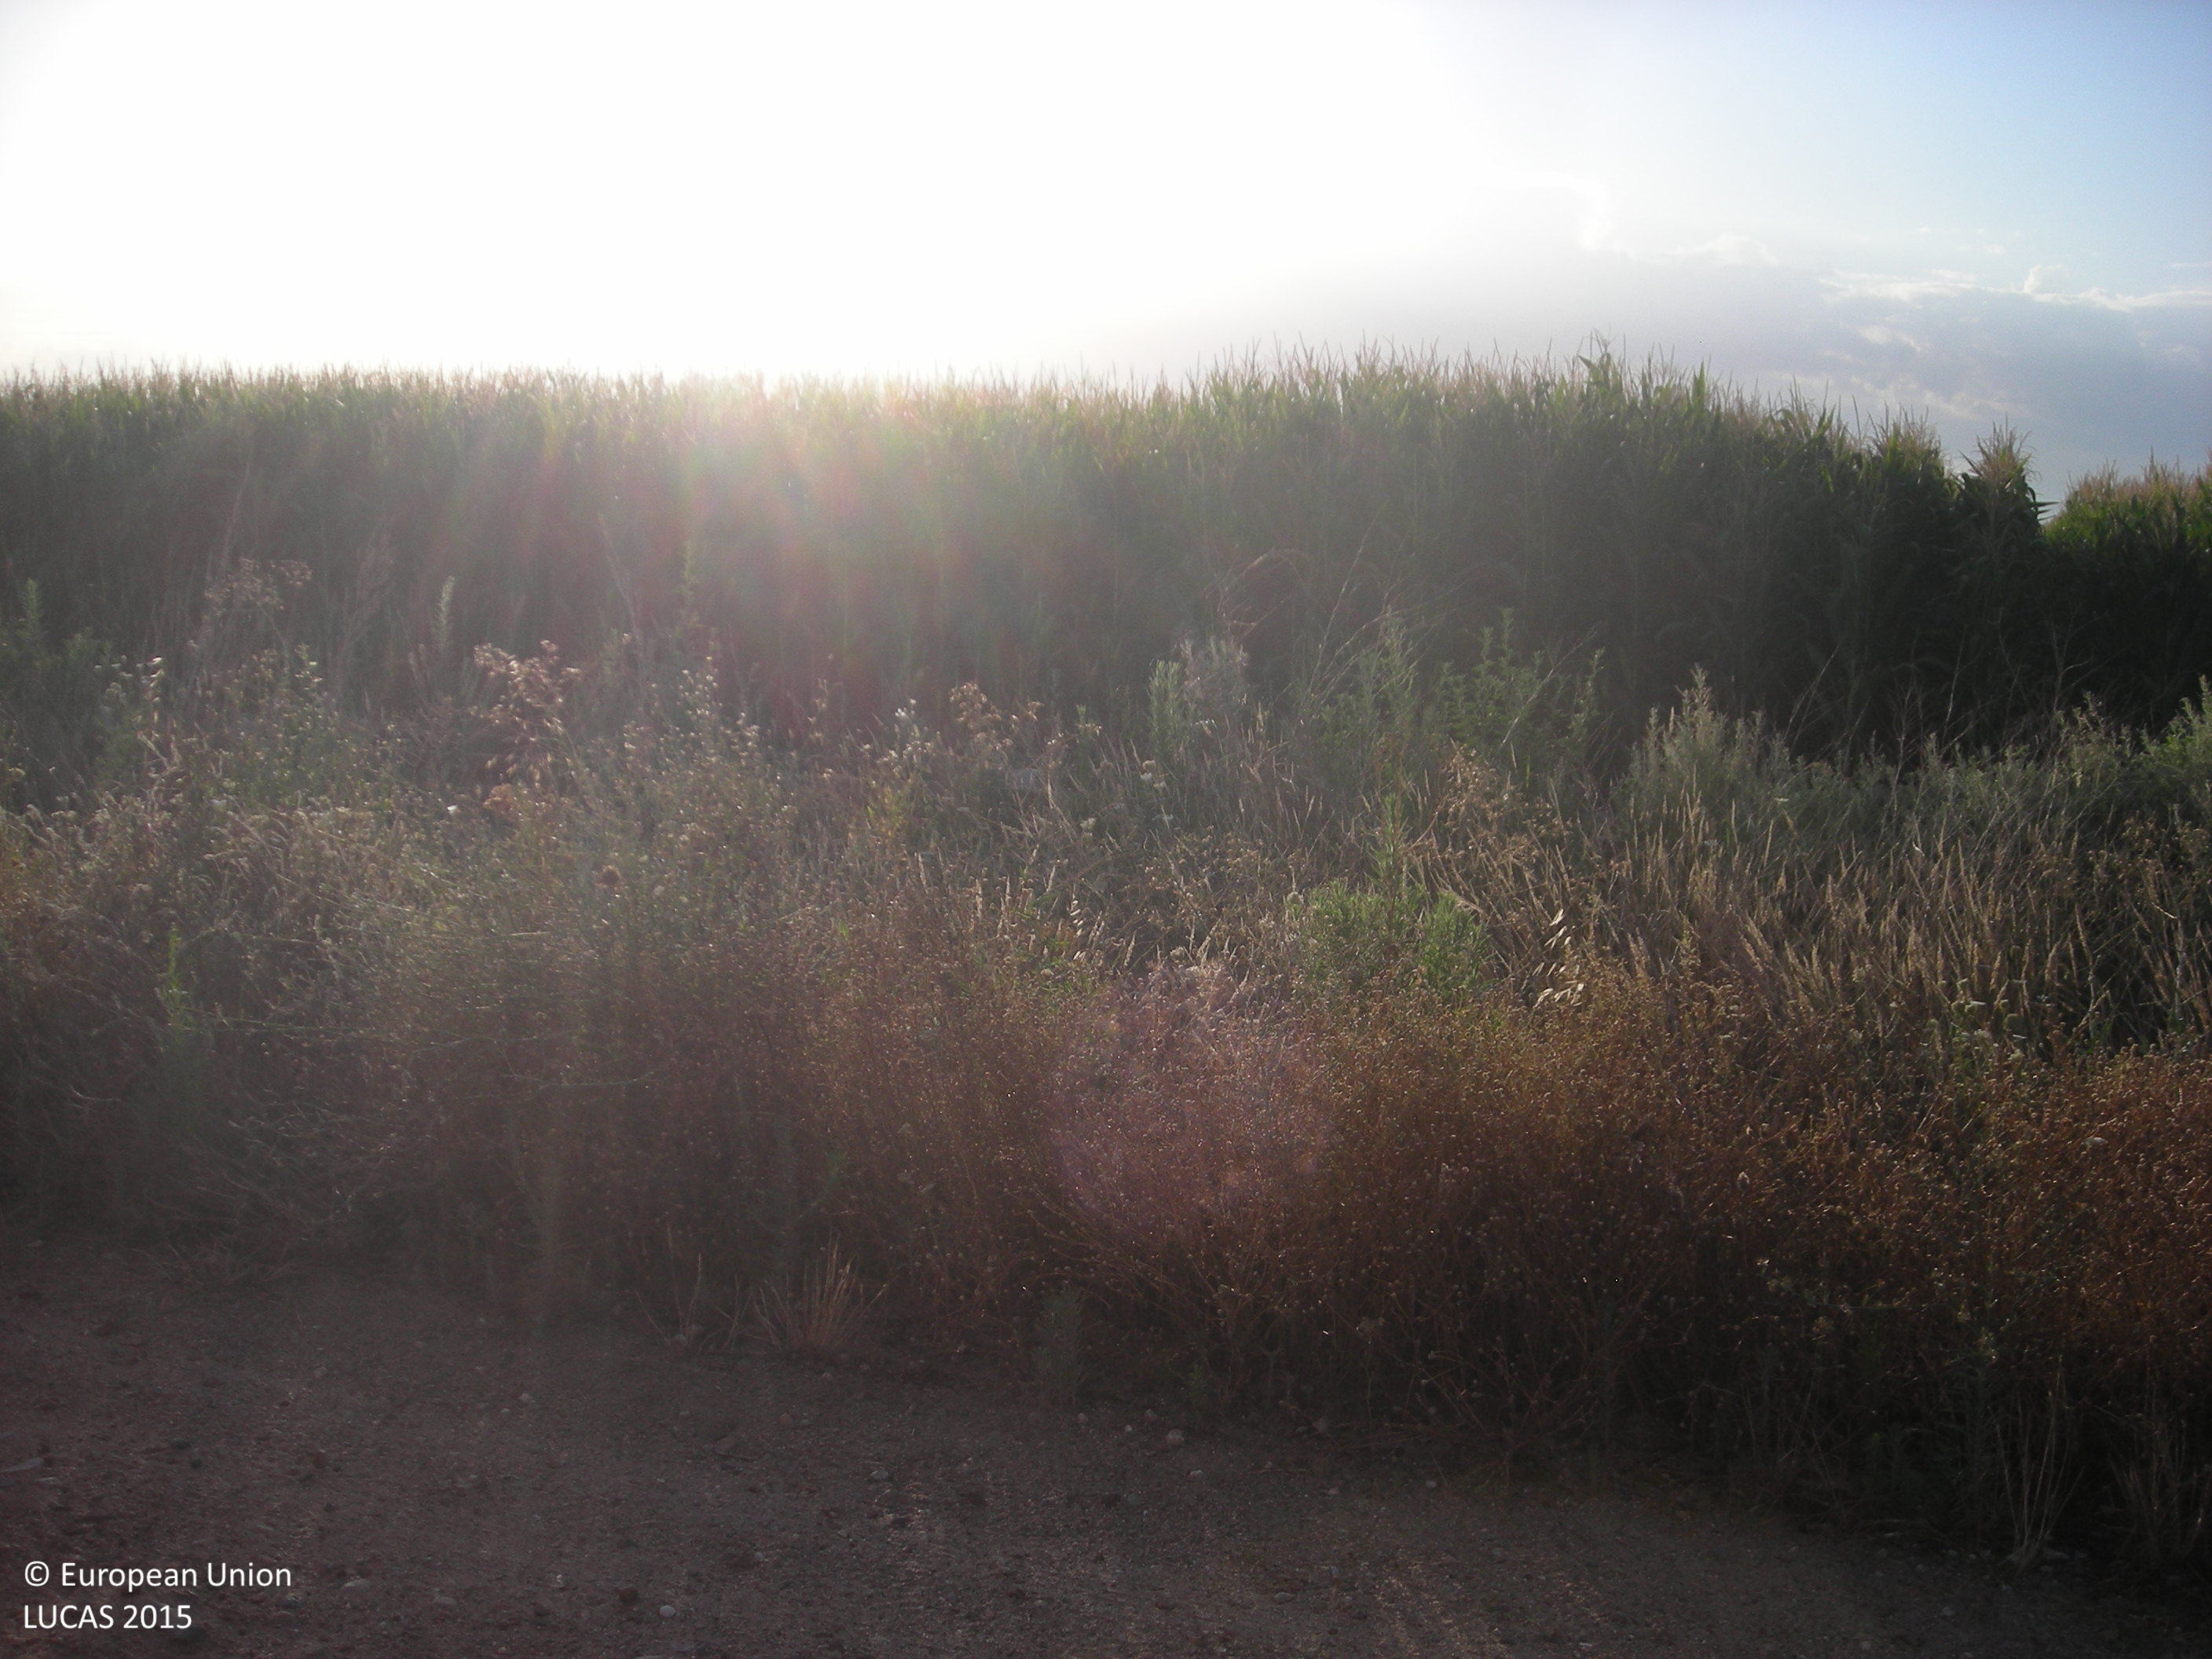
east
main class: Cropland
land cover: Tomatoes
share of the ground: > 75 %
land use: Agriculture (excluding fallow land and kitchen gardens)
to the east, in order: Tomatoes; Tracks; Ditches and canals; Electric lines; Grass margins; Ditches and canals; Tracks; Tomatoes
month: July
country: ES
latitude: 39.1276
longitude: -6.0065
